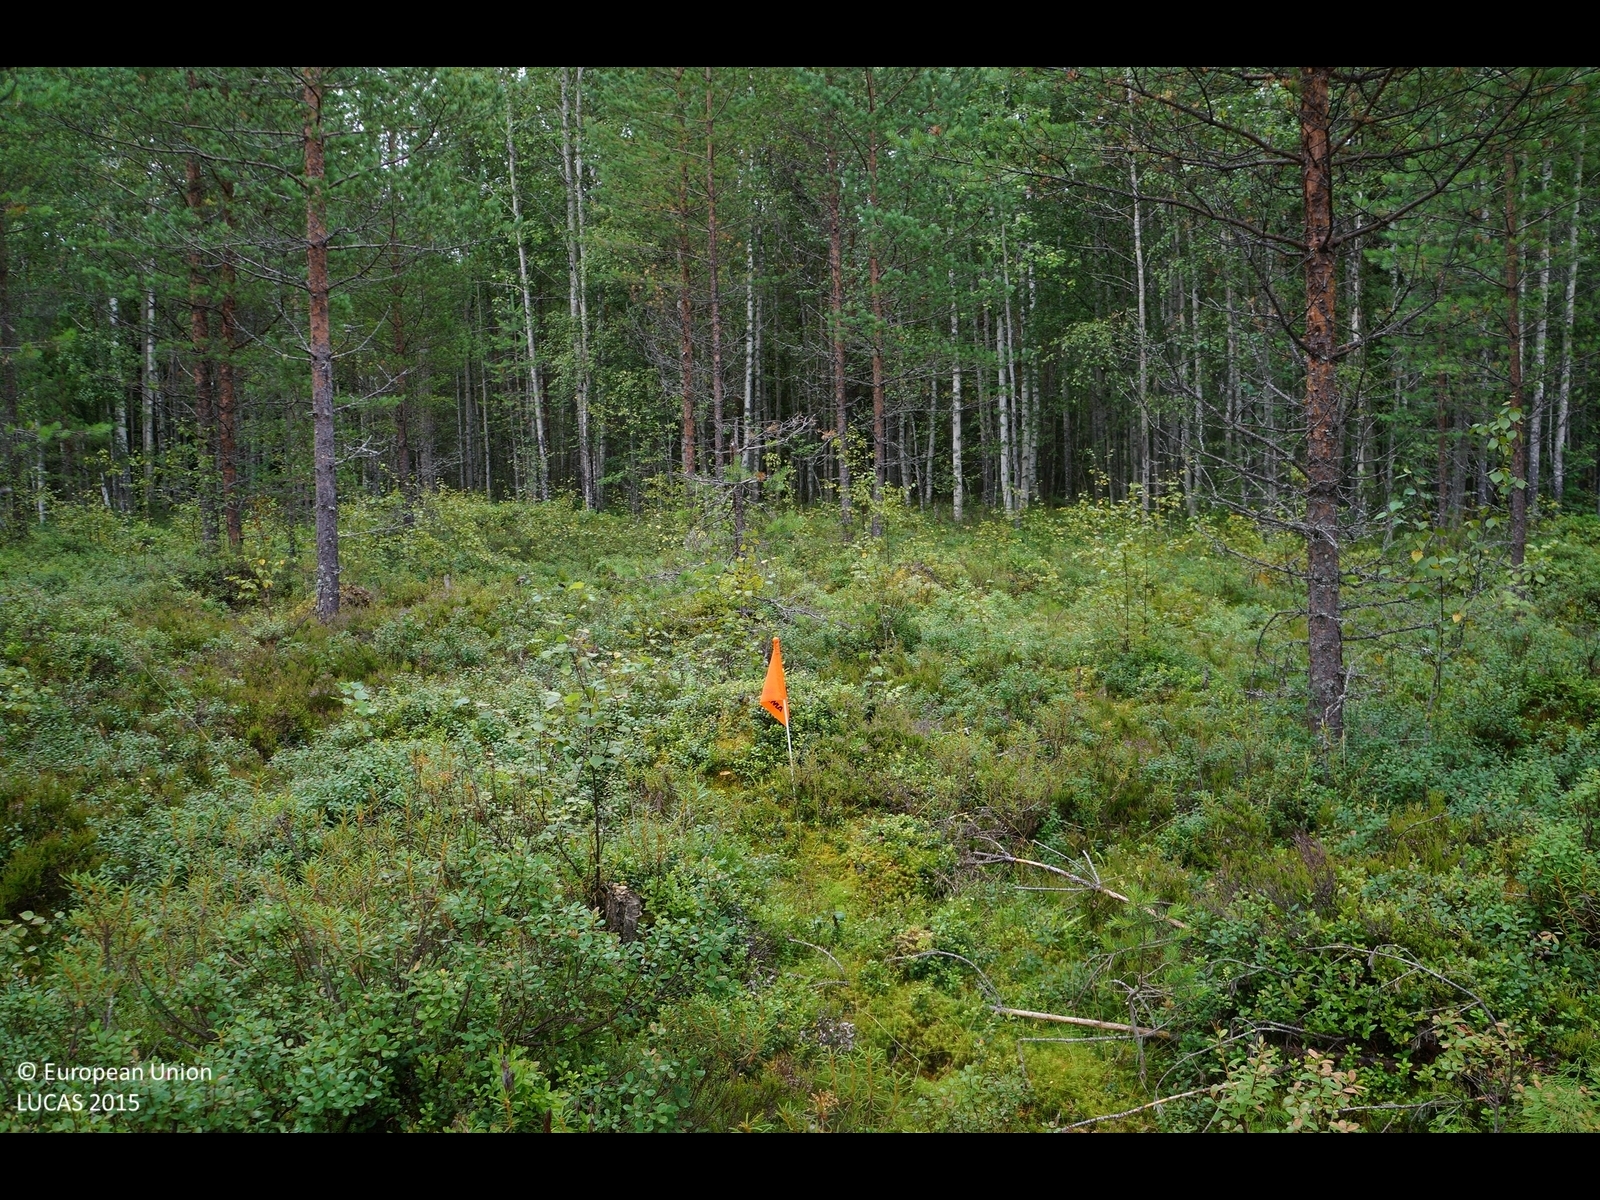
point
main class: Woodland
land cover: Pine dominated coniferous woodland
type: boreal forest
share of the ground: 25 - 50 %
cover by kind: shrubs 50 %, coniferous forest trees 35 %, lichens and mosses 10 %, broadleaved forest trees 5 %
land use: Forestry
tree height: > 5 m
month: August
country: FI
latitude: 64.2872
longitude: 25.9478
